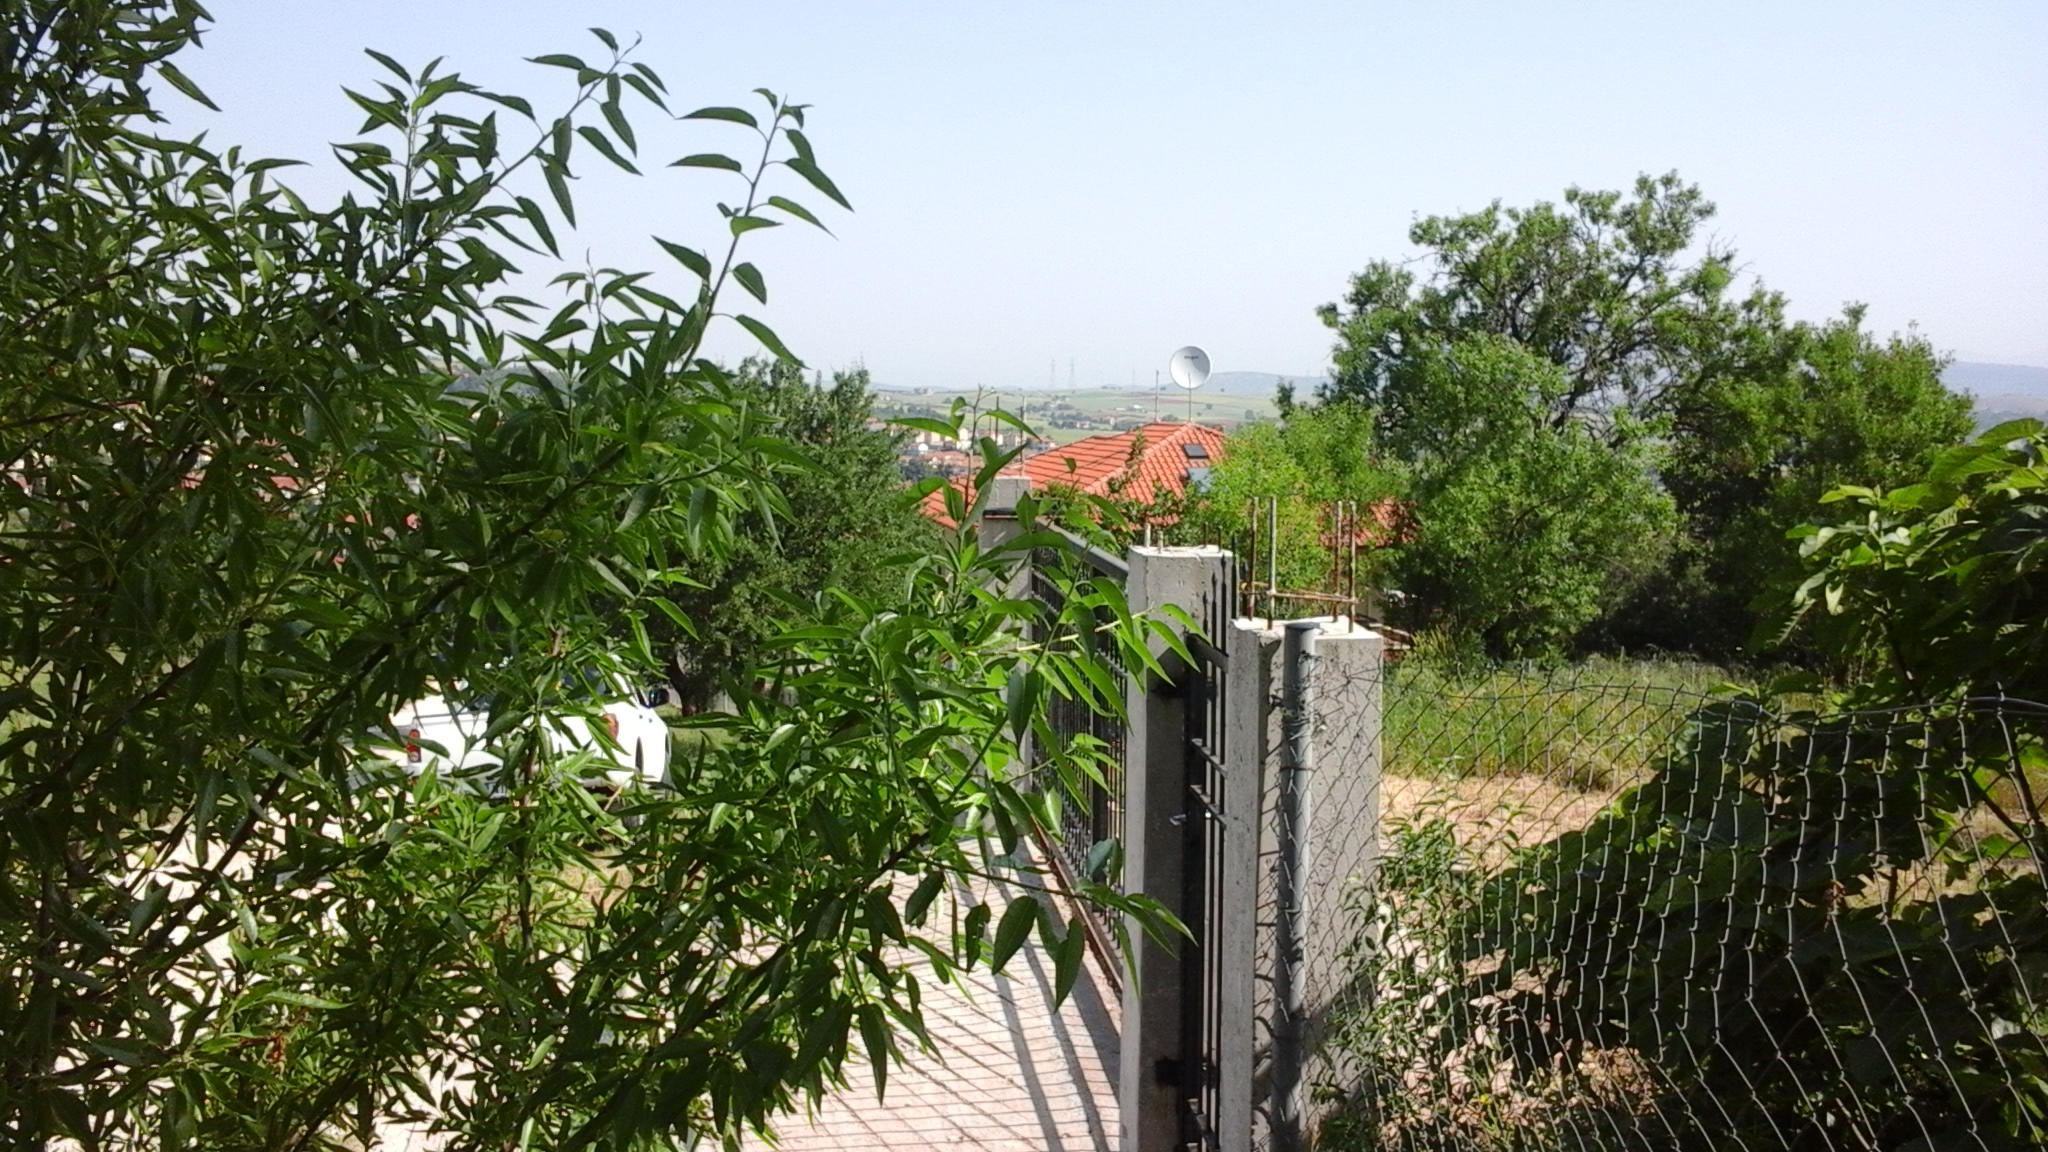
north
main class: Cropland
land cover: Nuts trees
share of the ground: 50 - 75 %
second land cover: Spontaneously vegetated surfaces
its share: > 75 %
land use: Agriculture (excluding fallow land and kitchen gardens)
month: May
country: GR
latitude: 40.7611
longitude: 22.9323
